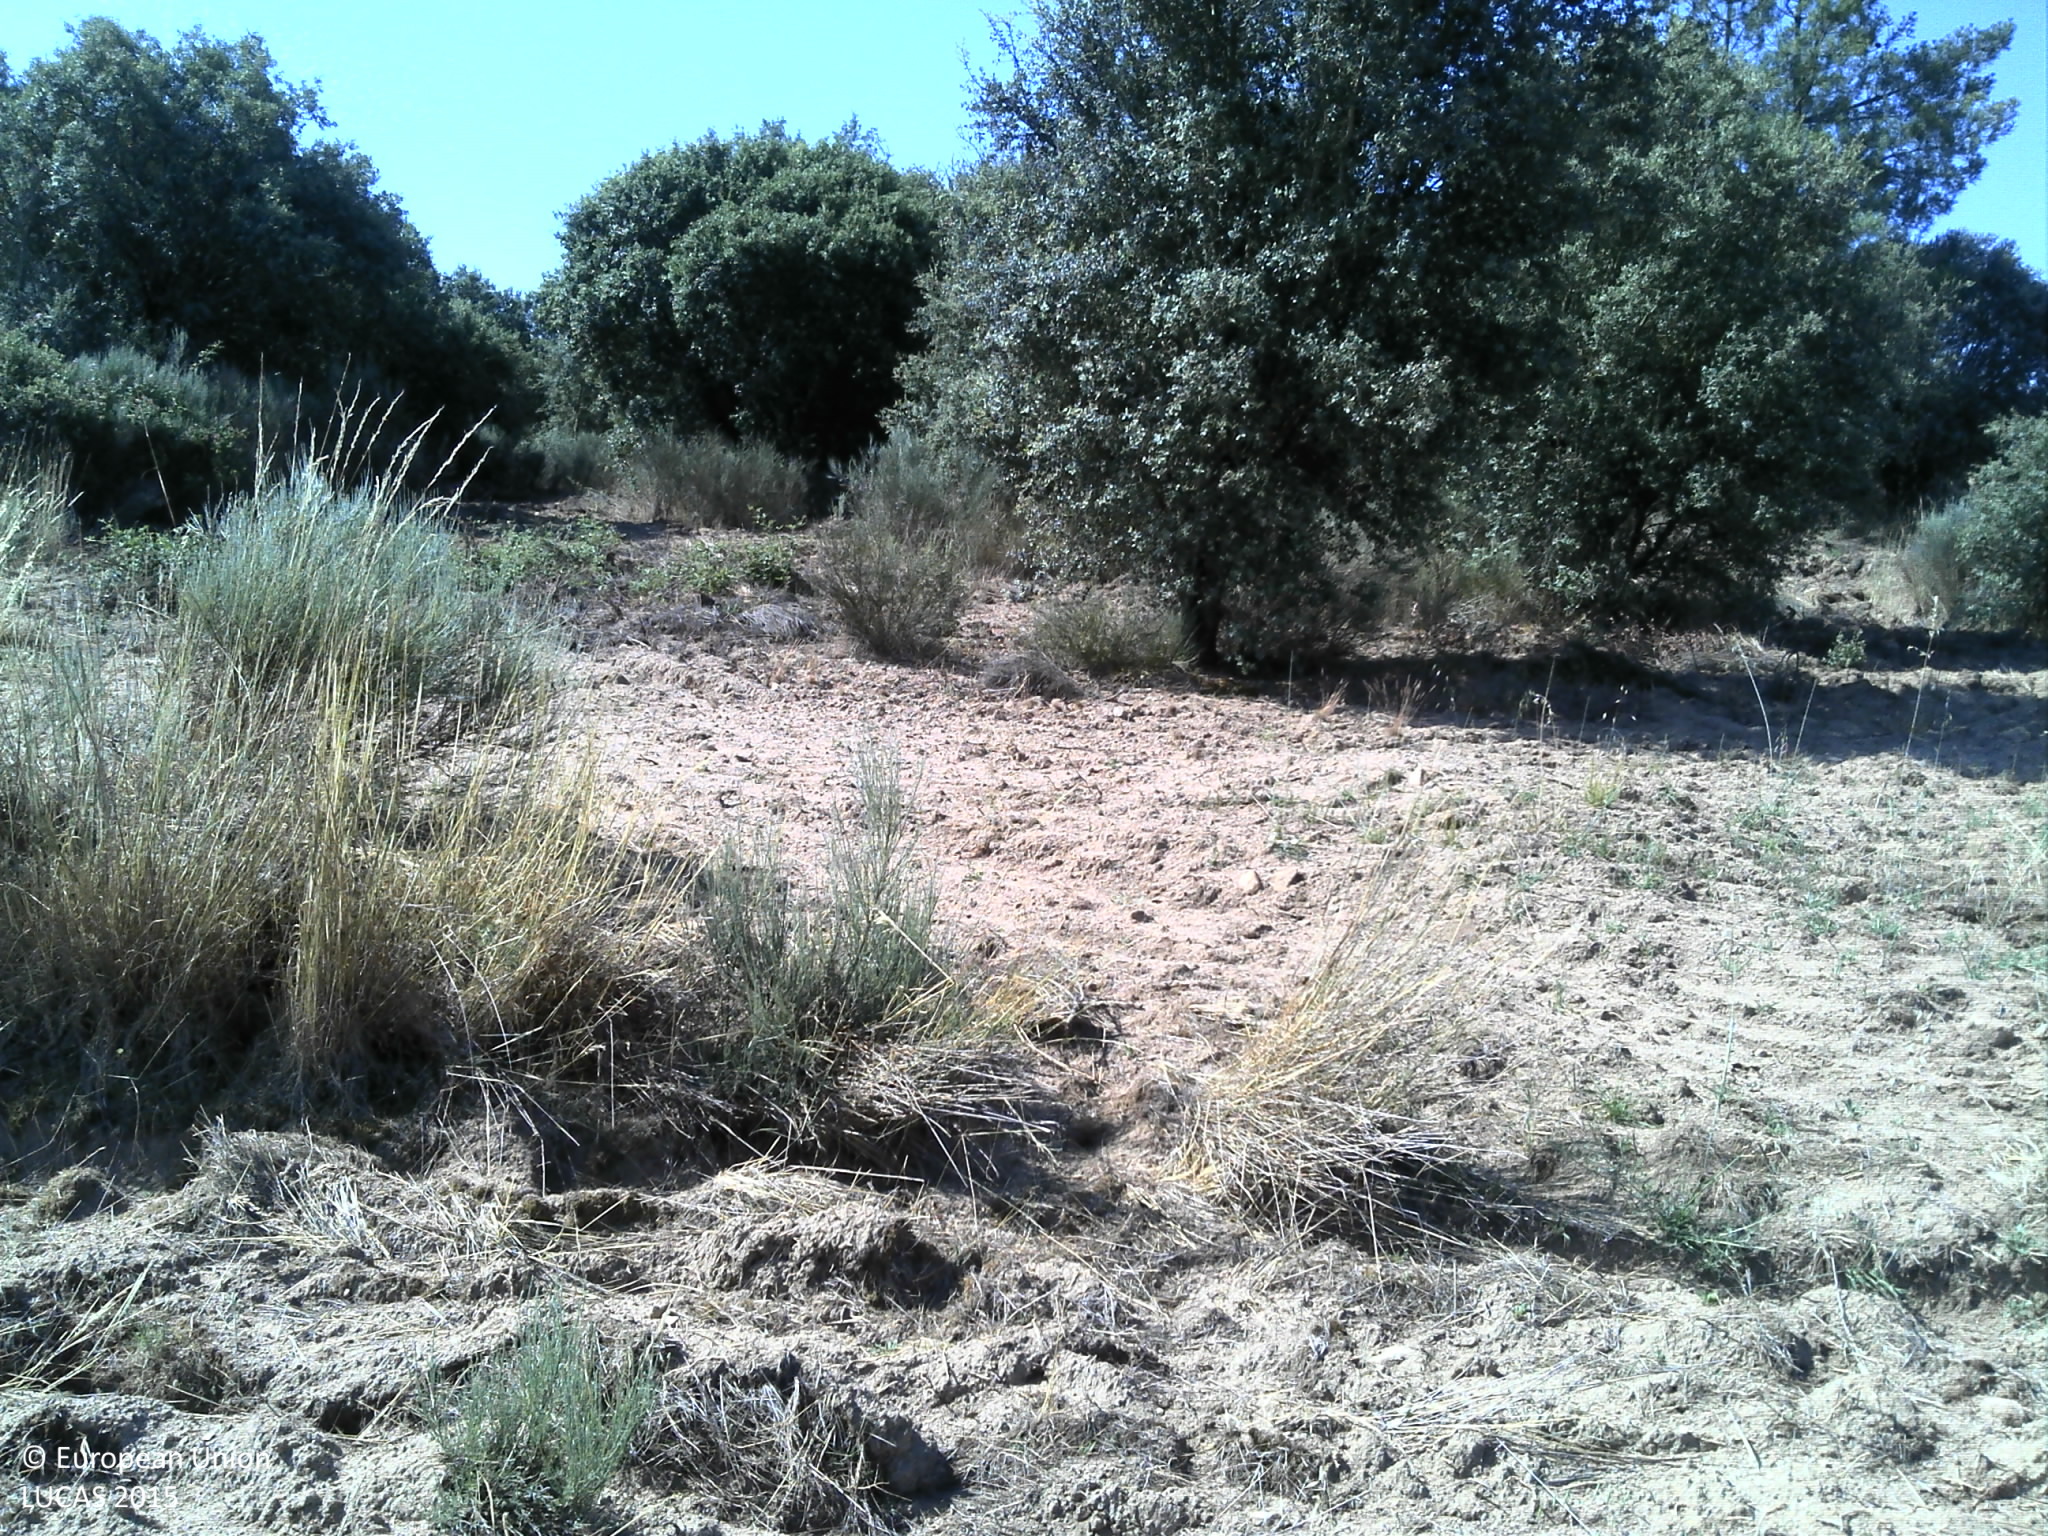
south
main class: Grassland
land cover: Spontaneously vegetated surfaces
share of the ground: 10 - 25 %
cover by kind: unconsolidated bare surface 85 %, herbaceous plants 15 %
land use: Fallow land
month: June
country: PT
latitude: 40.7772
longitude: -6.9146
